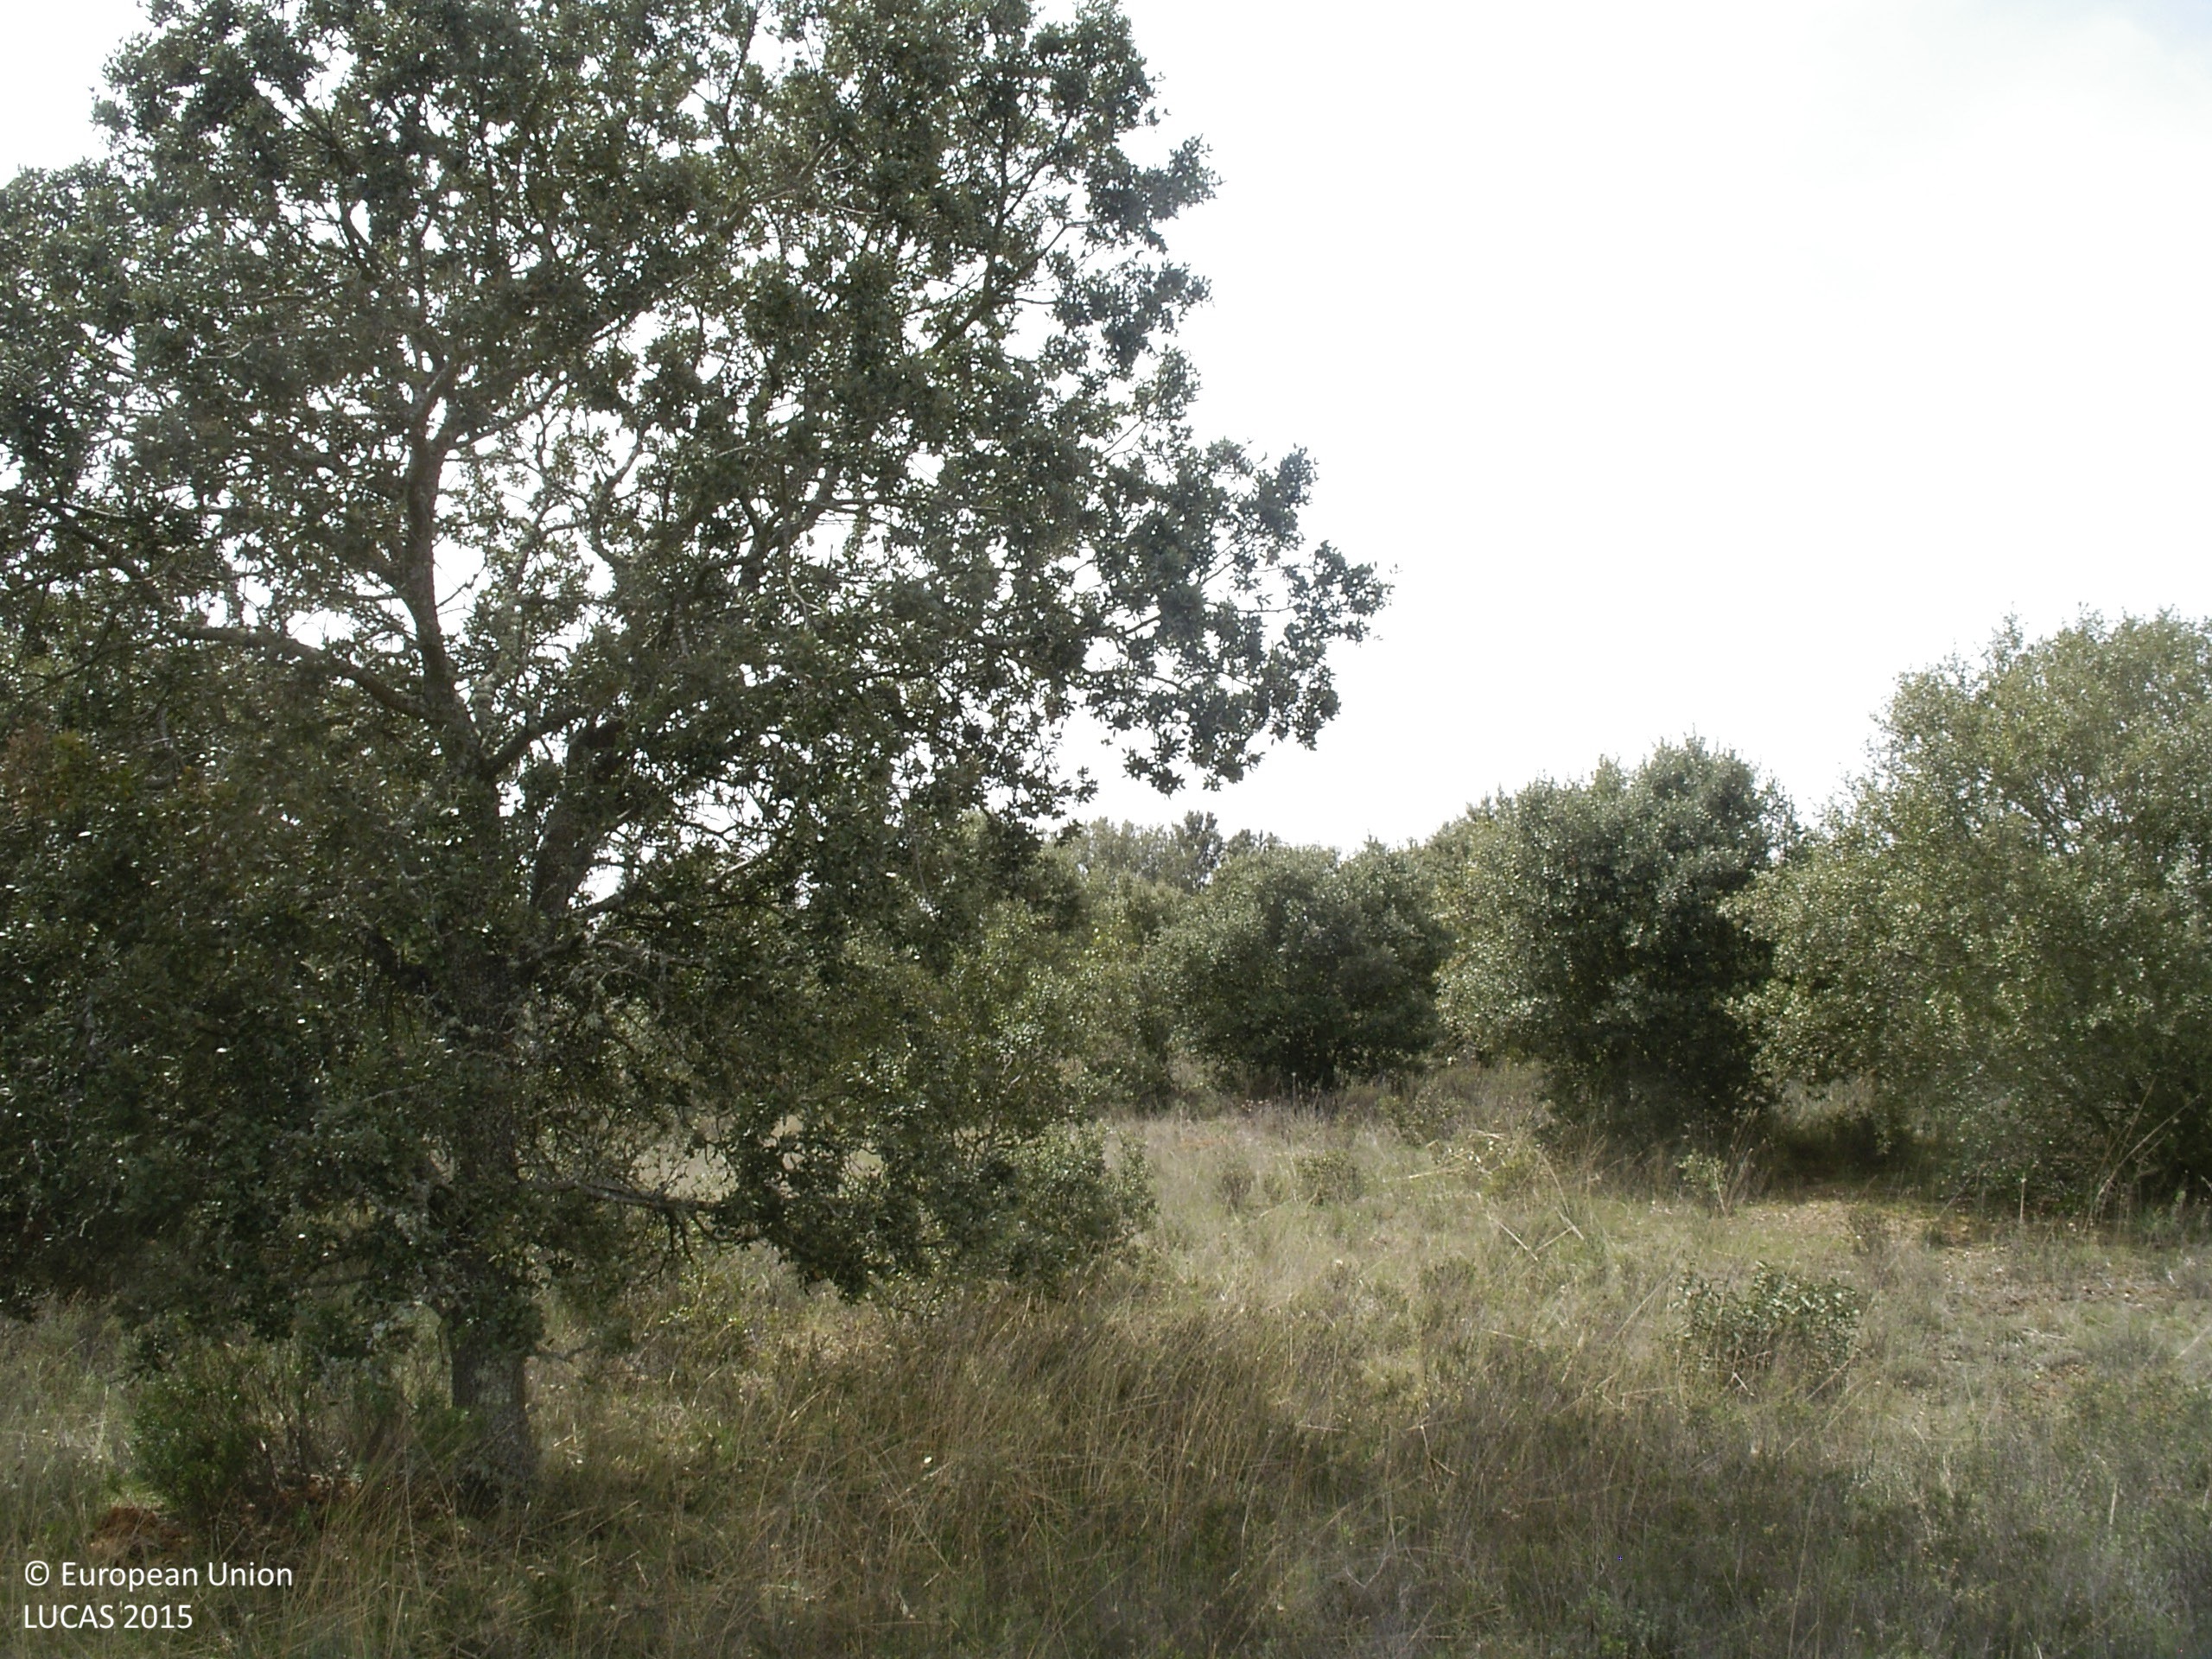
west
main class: Shrubland
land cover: Shrubland with sparse tree cover
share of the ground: > 75 %
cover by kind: herbaceous plants 85 %, shrubs 10 %, broadleaved forest trees 5 %
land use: Agriculture (excluding fallow land and kitchen gardens)
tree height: > 5 m
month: April
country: ES
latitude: 42.3987
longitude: -6.1312
